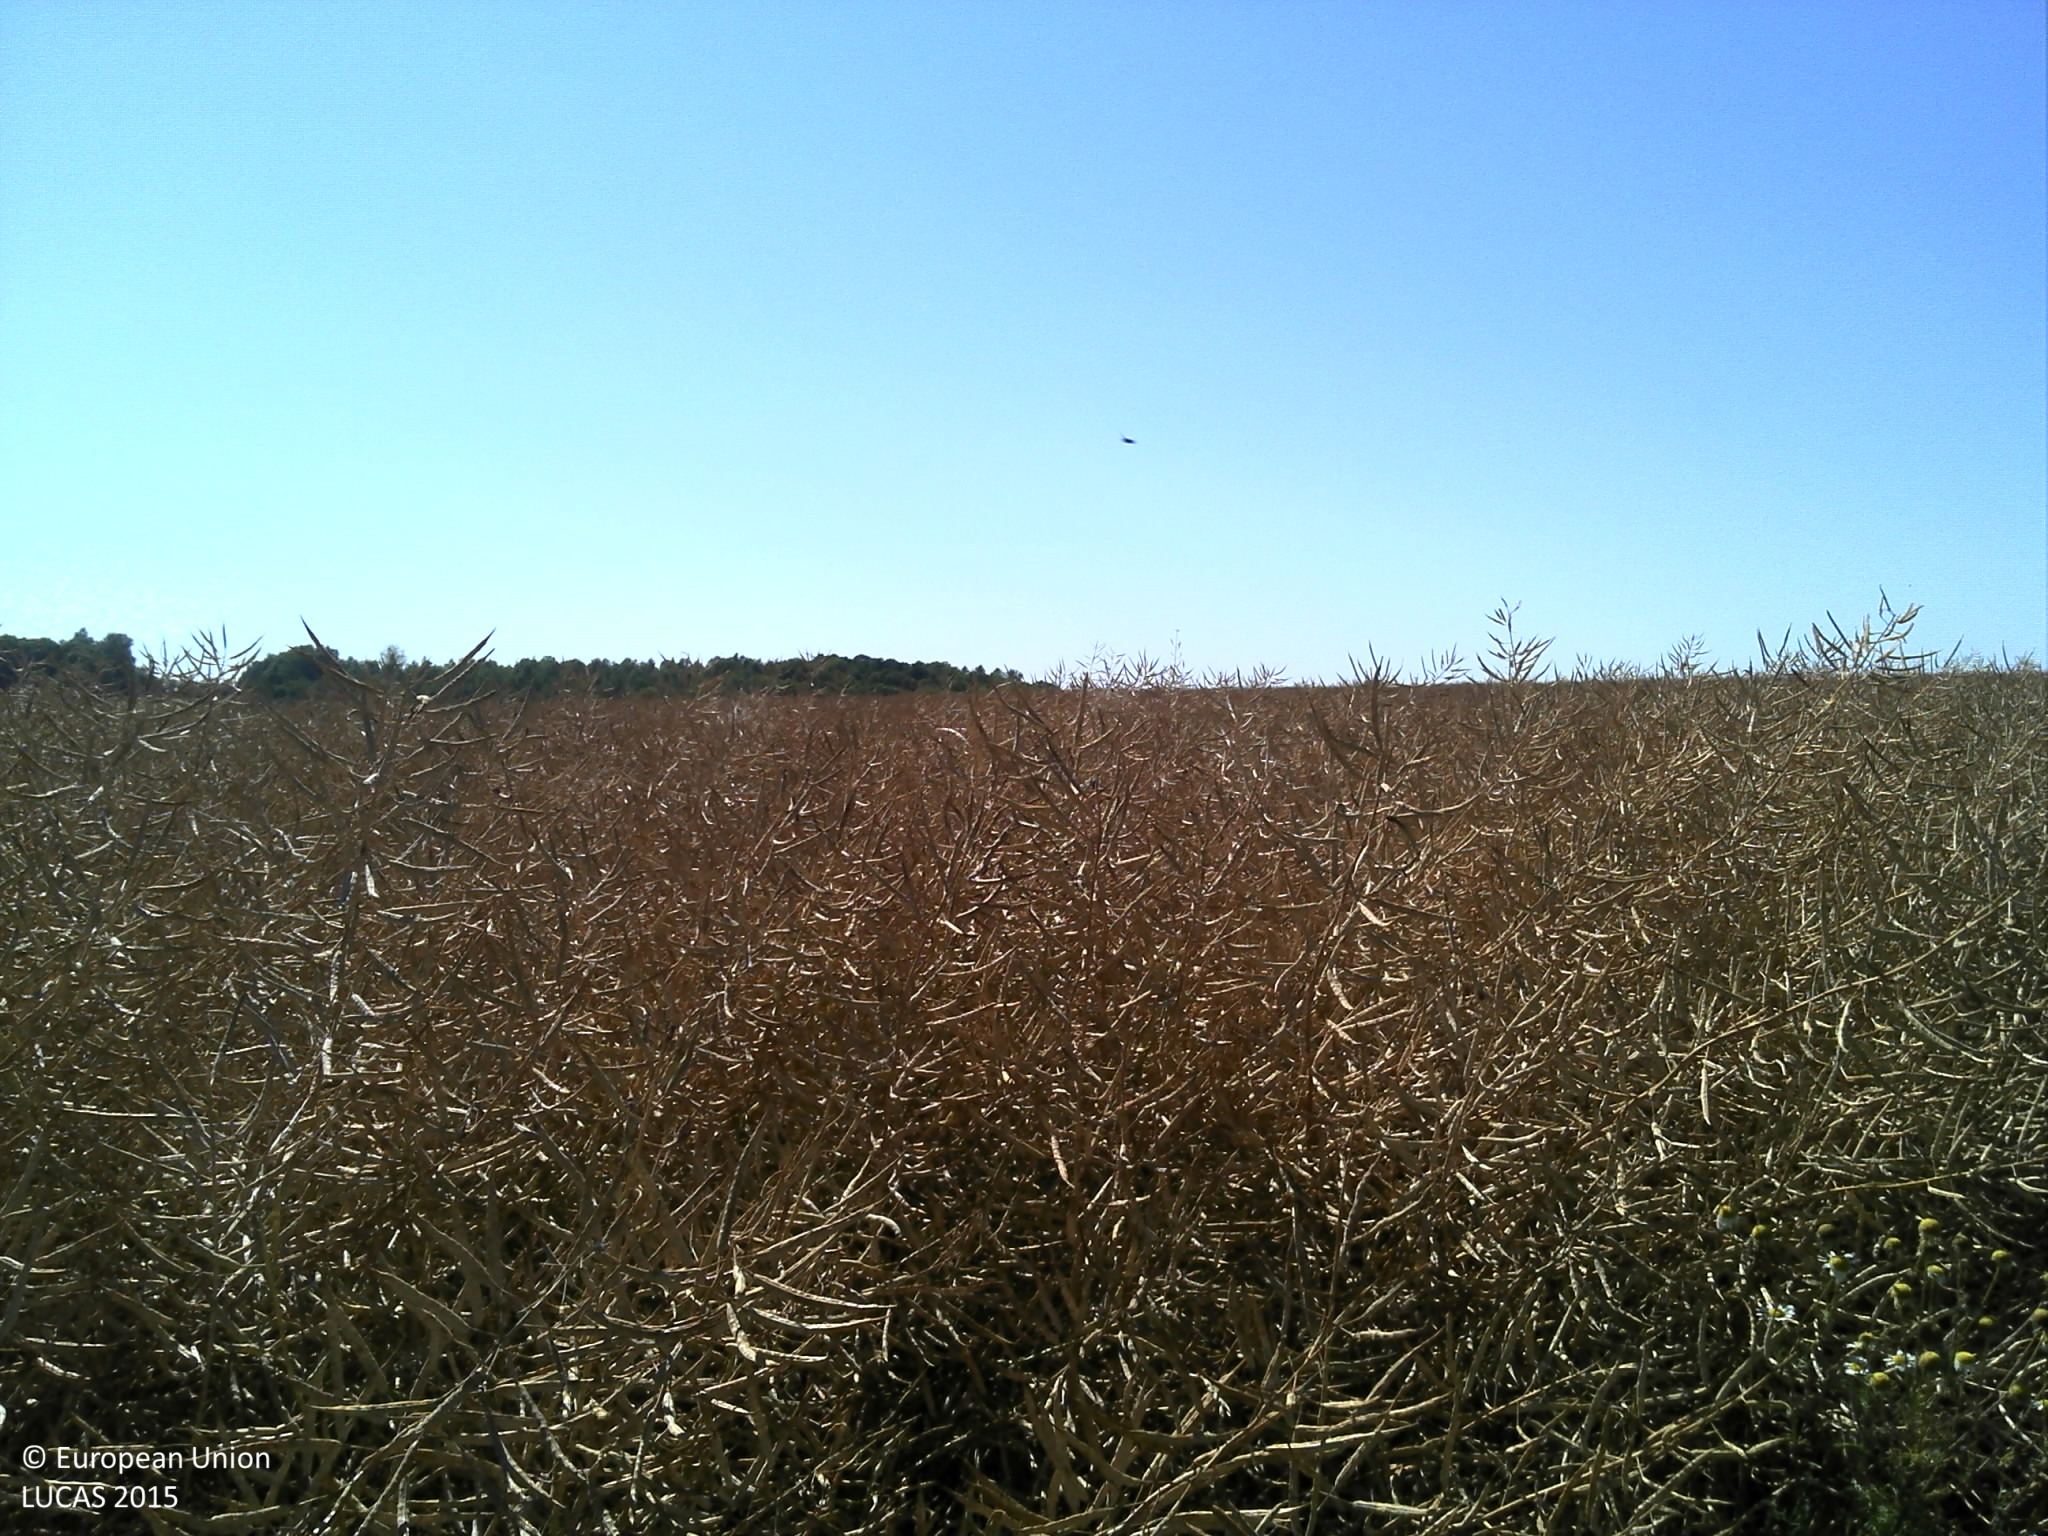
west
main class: Cropland
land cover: Rape and turnip rape
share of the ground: > 75 %
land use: Agriculture (excluding fallow land and kitchen gardens)
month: July
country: FR
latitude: 49.4835
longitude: 4.6825
